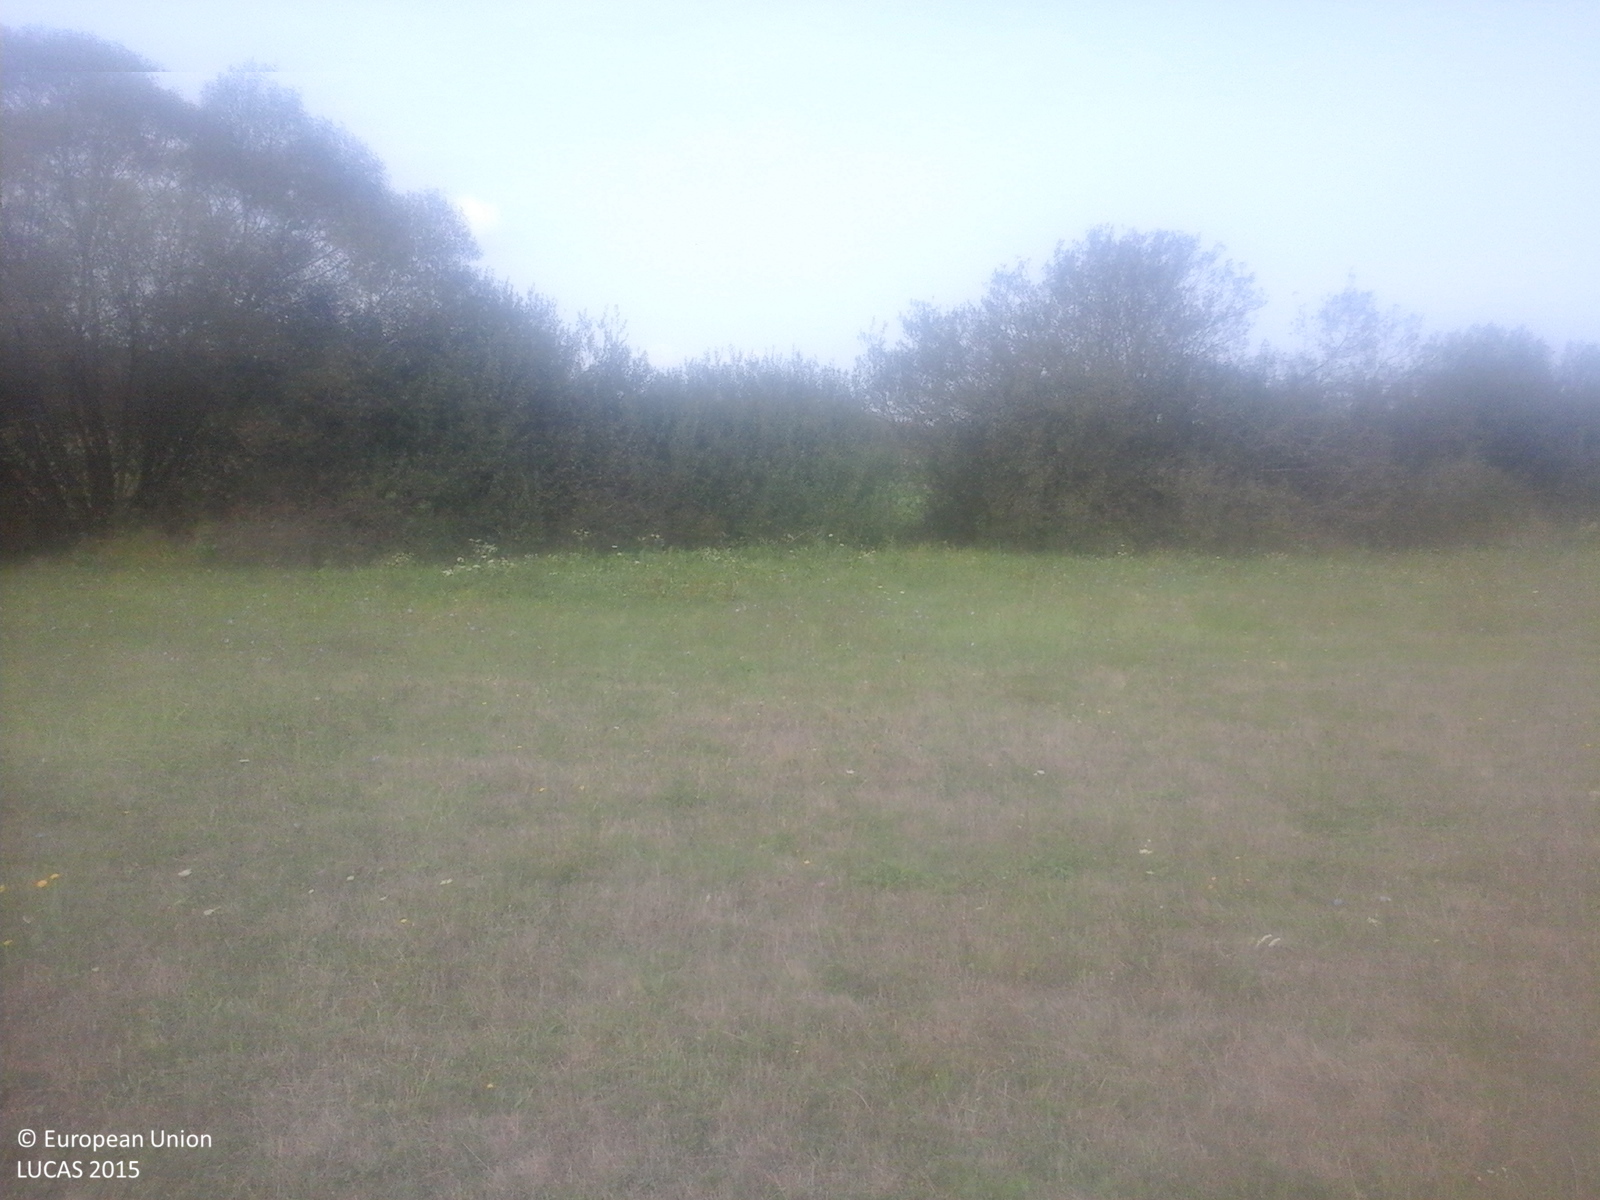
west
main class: Grassland
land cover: Grassland without tree/shrub cover
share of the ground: > 75 %
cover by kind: herbaceous plants 100 %
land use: Agriculture (excluding fallow land and kitchen gardens)
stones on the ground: < 10 %
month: September
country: RO
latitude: 45.4402
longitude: 21.9653
